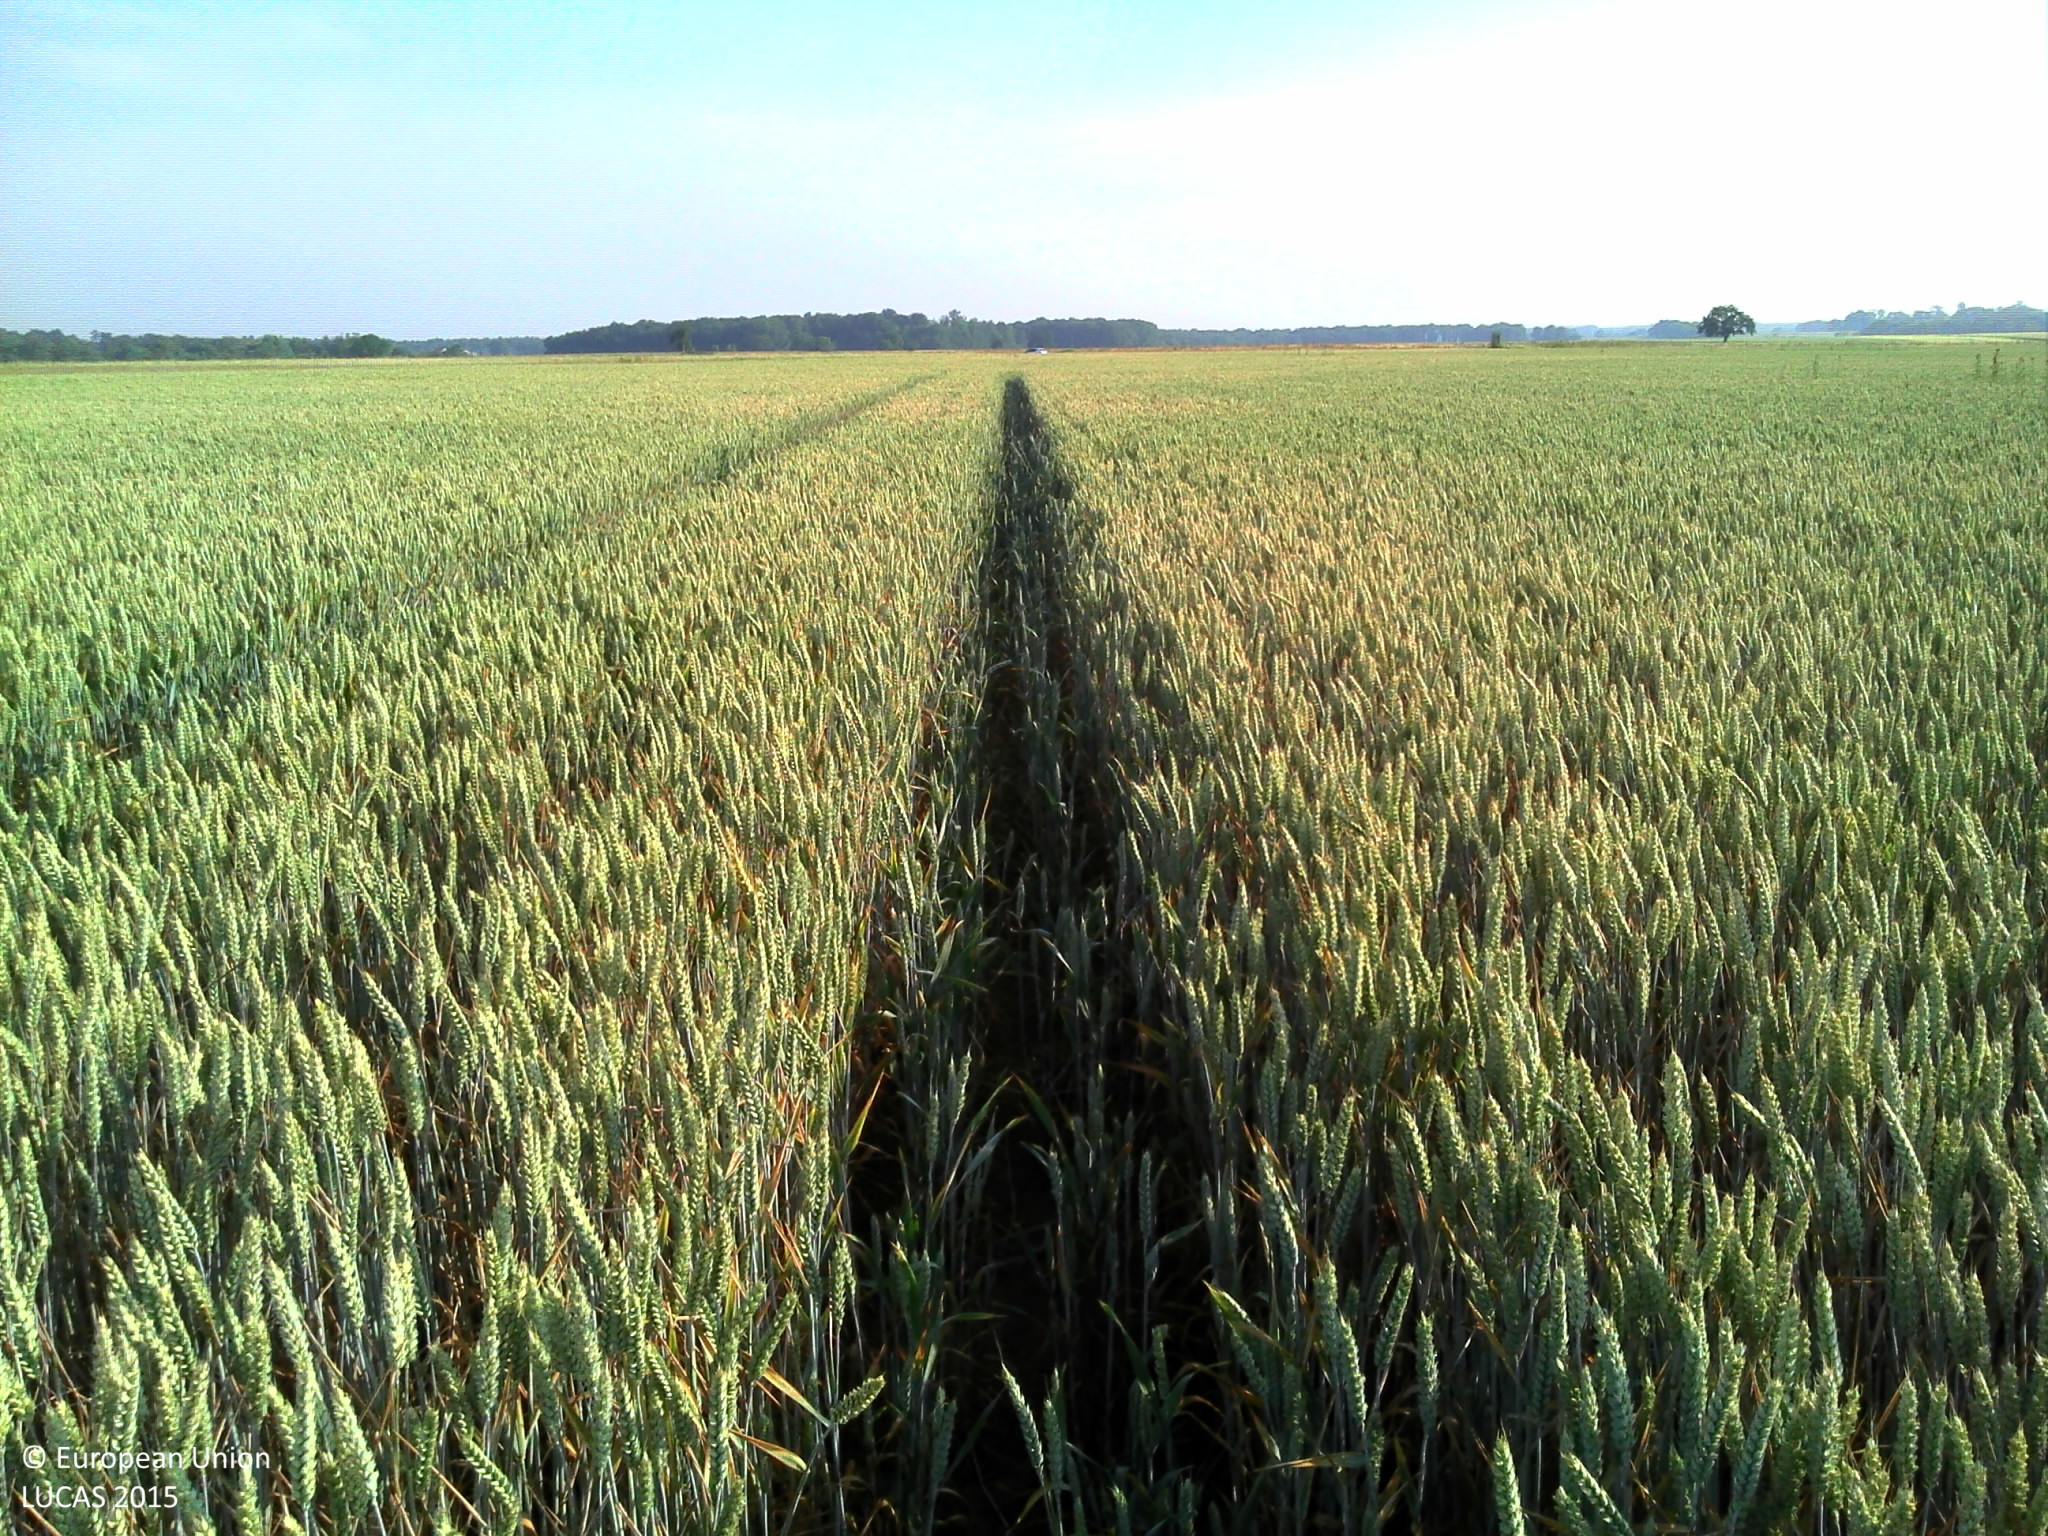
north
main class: Cropland
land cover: Common wheat
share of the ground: > 75 %
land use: Agriculture (excluding fallow land and kitchen gardens)
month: June
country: FR
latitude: 46.5642
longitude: 0.5244
